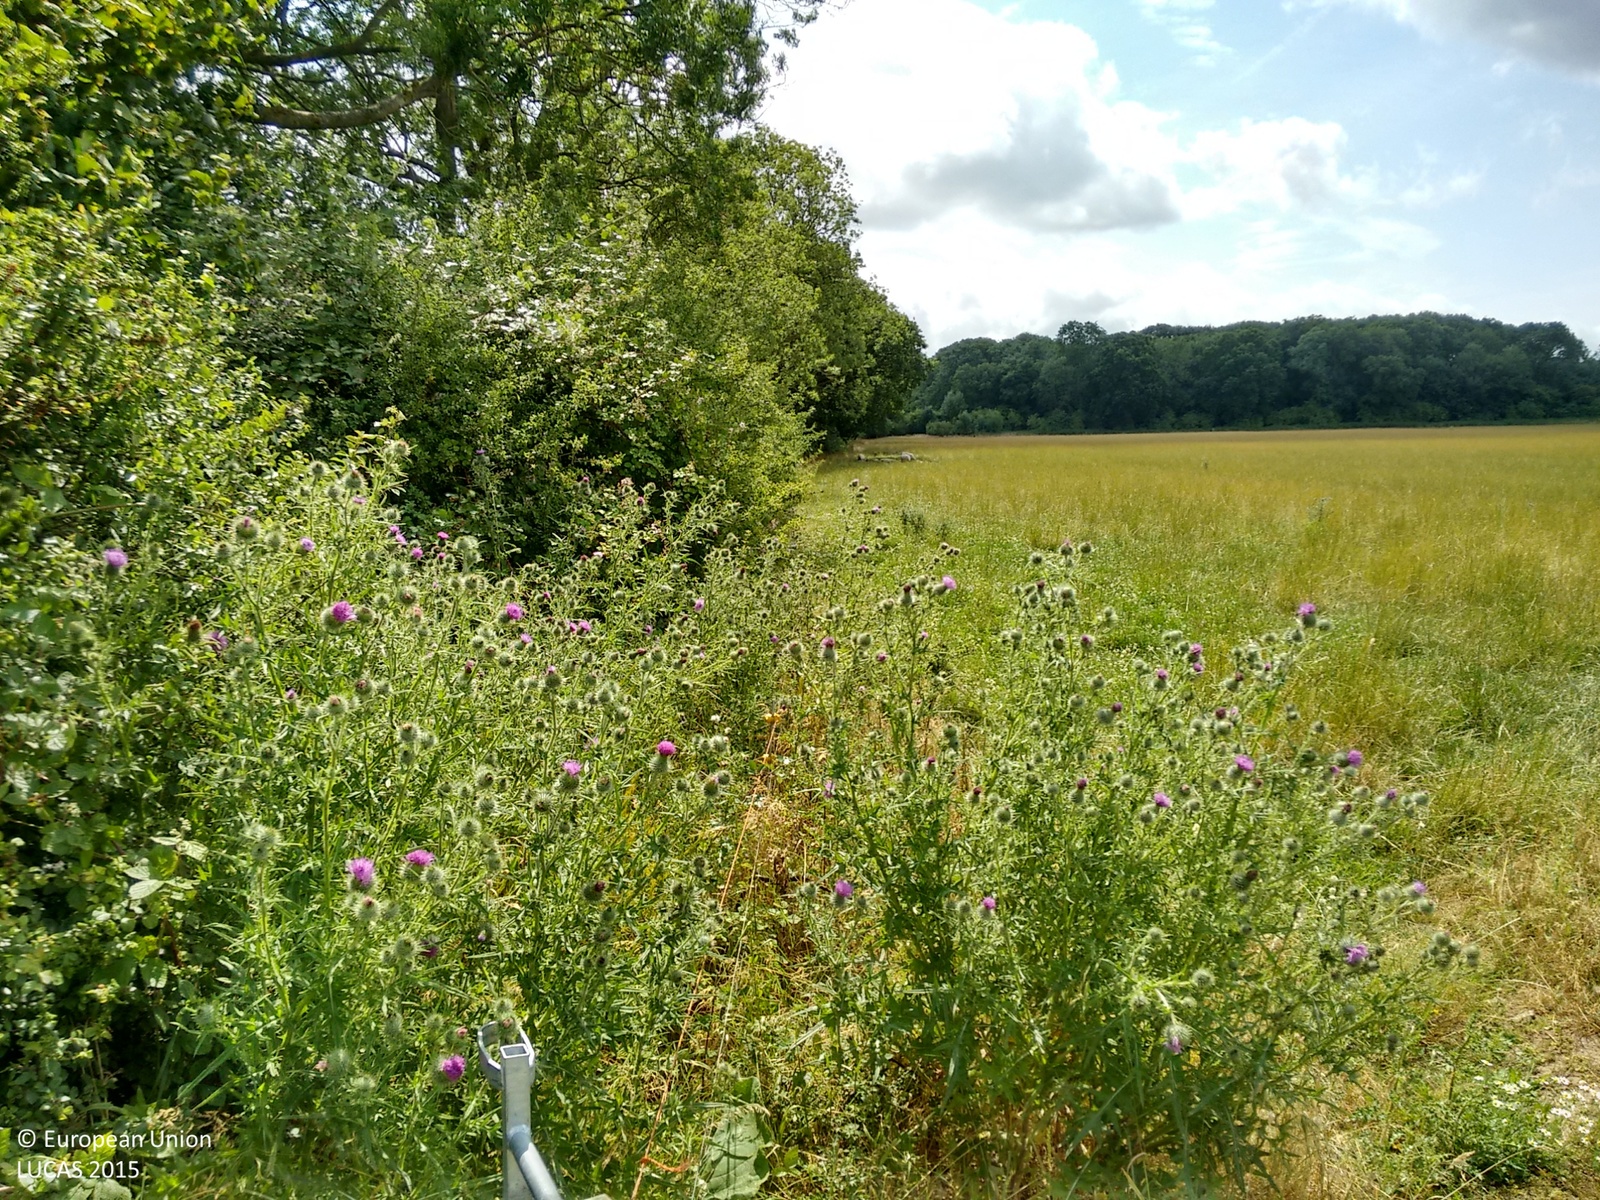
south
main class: Grassland
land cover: Grassland without tree/shrub cover
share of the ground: > 75 %
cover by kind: herbaceous plants 100 %
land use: Agriculture (excluding fallow land and kitchen gardens)
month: July
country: GB
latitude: 51.2768
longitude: -0.4887
